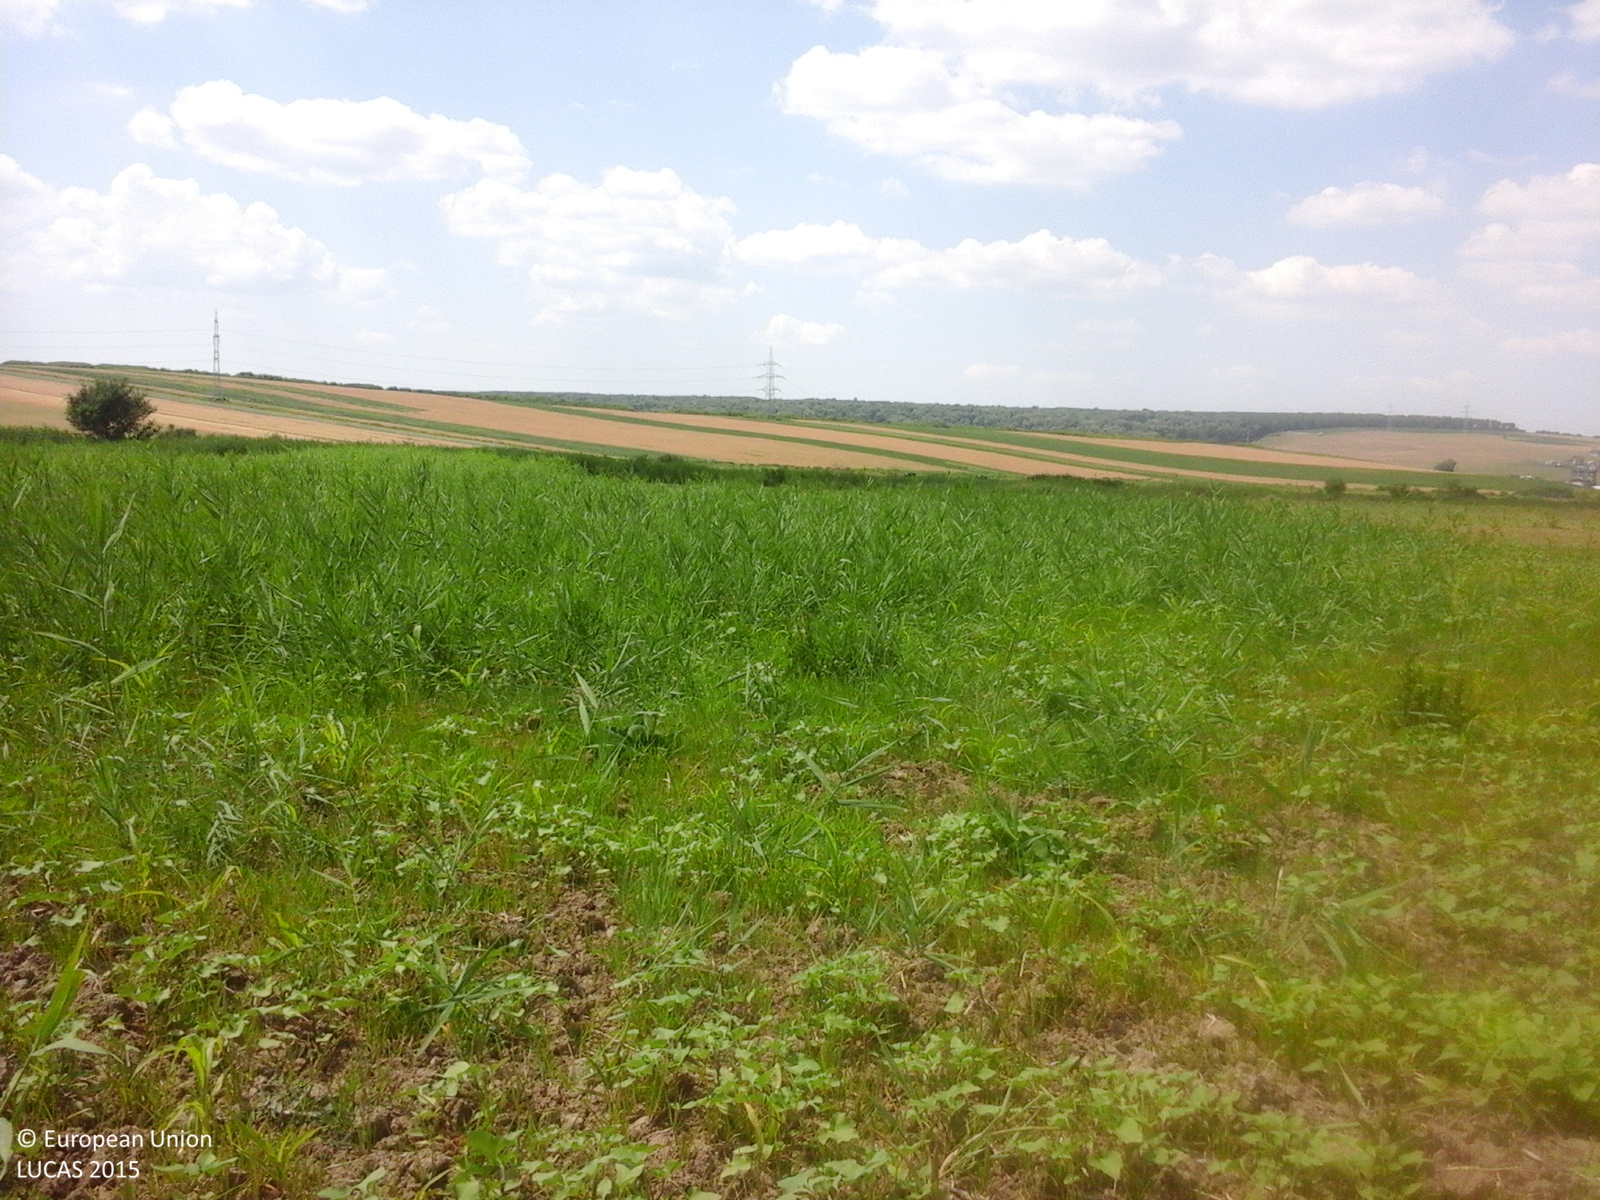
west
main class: Grassland
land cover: Spontaneously vegetated surfaces
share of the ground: > 75 %
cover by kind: herbaceous plants 100 %
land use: Fallow land
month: June
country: RO
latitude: 47.0567
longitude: 27.5606
